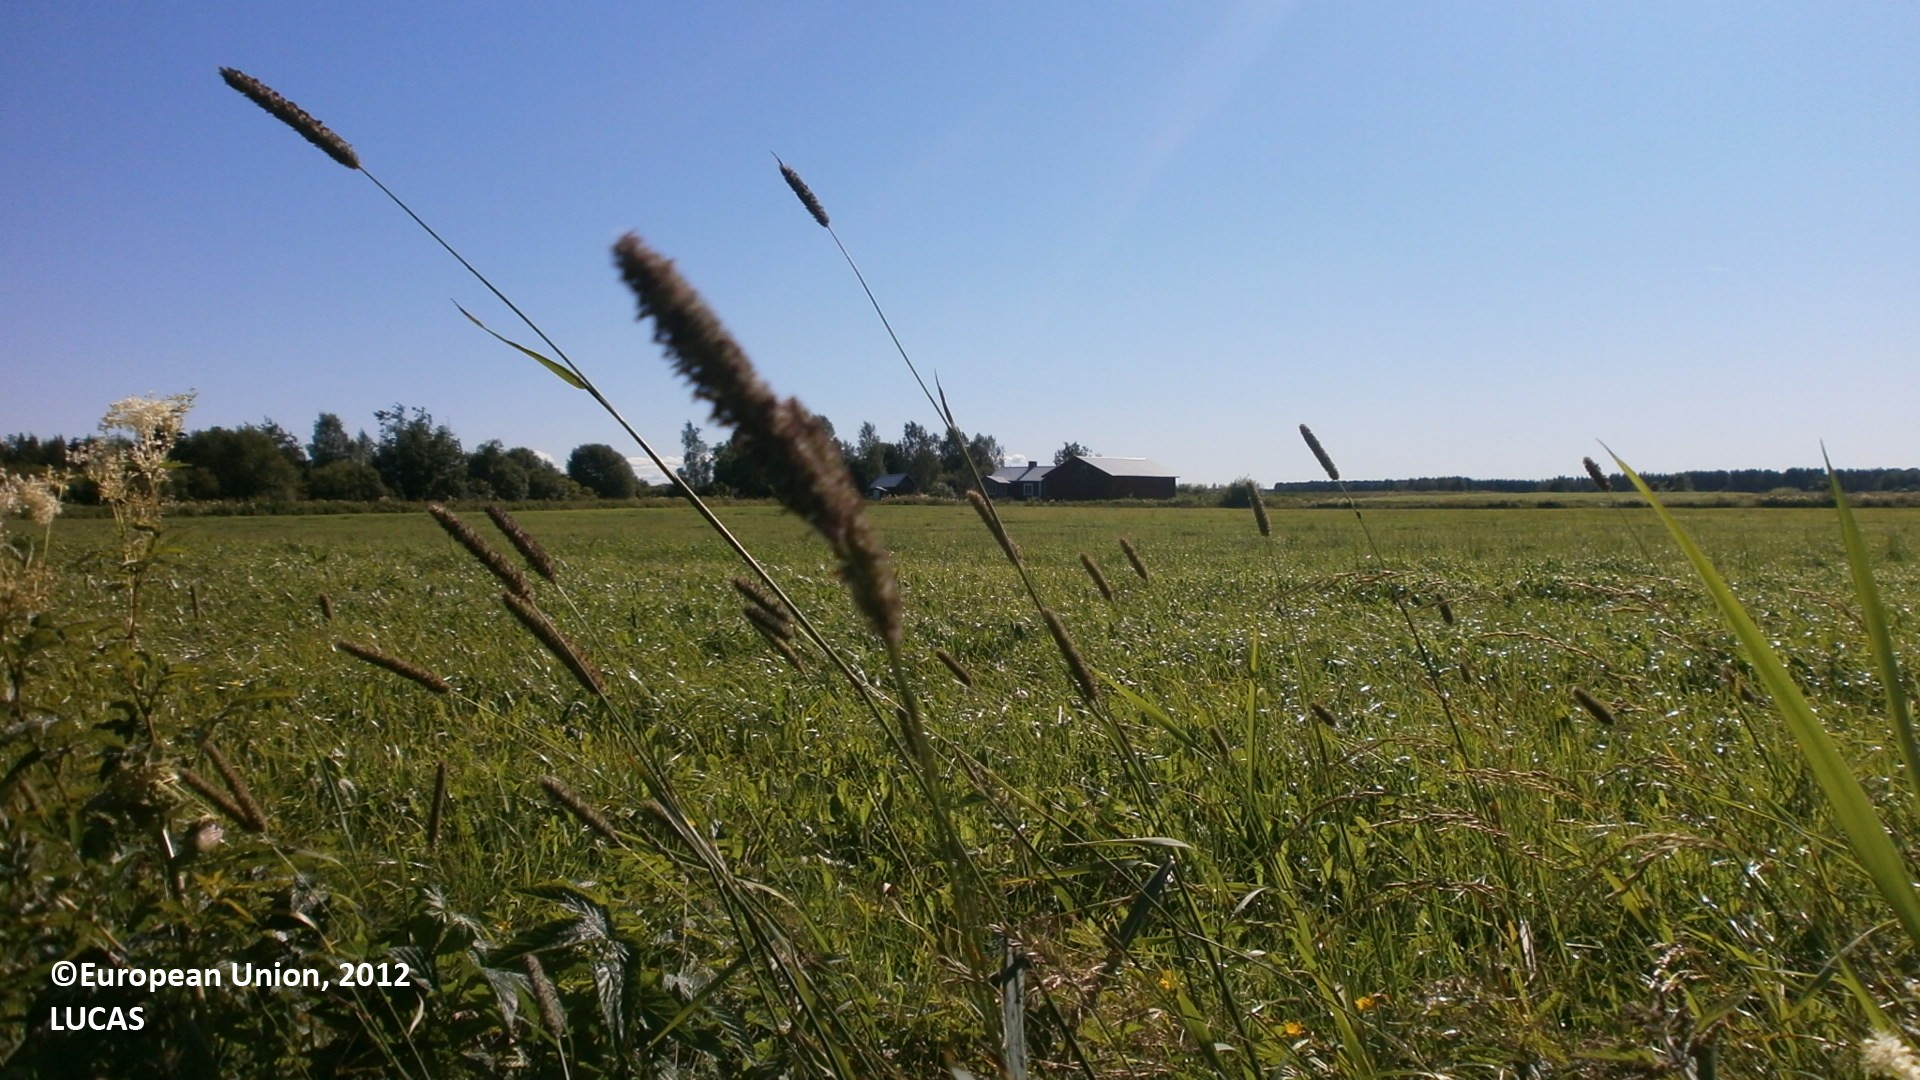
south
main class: Shrubland
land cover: Shrubland without tree cover
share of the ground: > 75 %
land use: Agriculture (excluding fallow land and kitchen gardens)
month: July
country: FI
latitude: 64.1437
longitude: 23.9768
